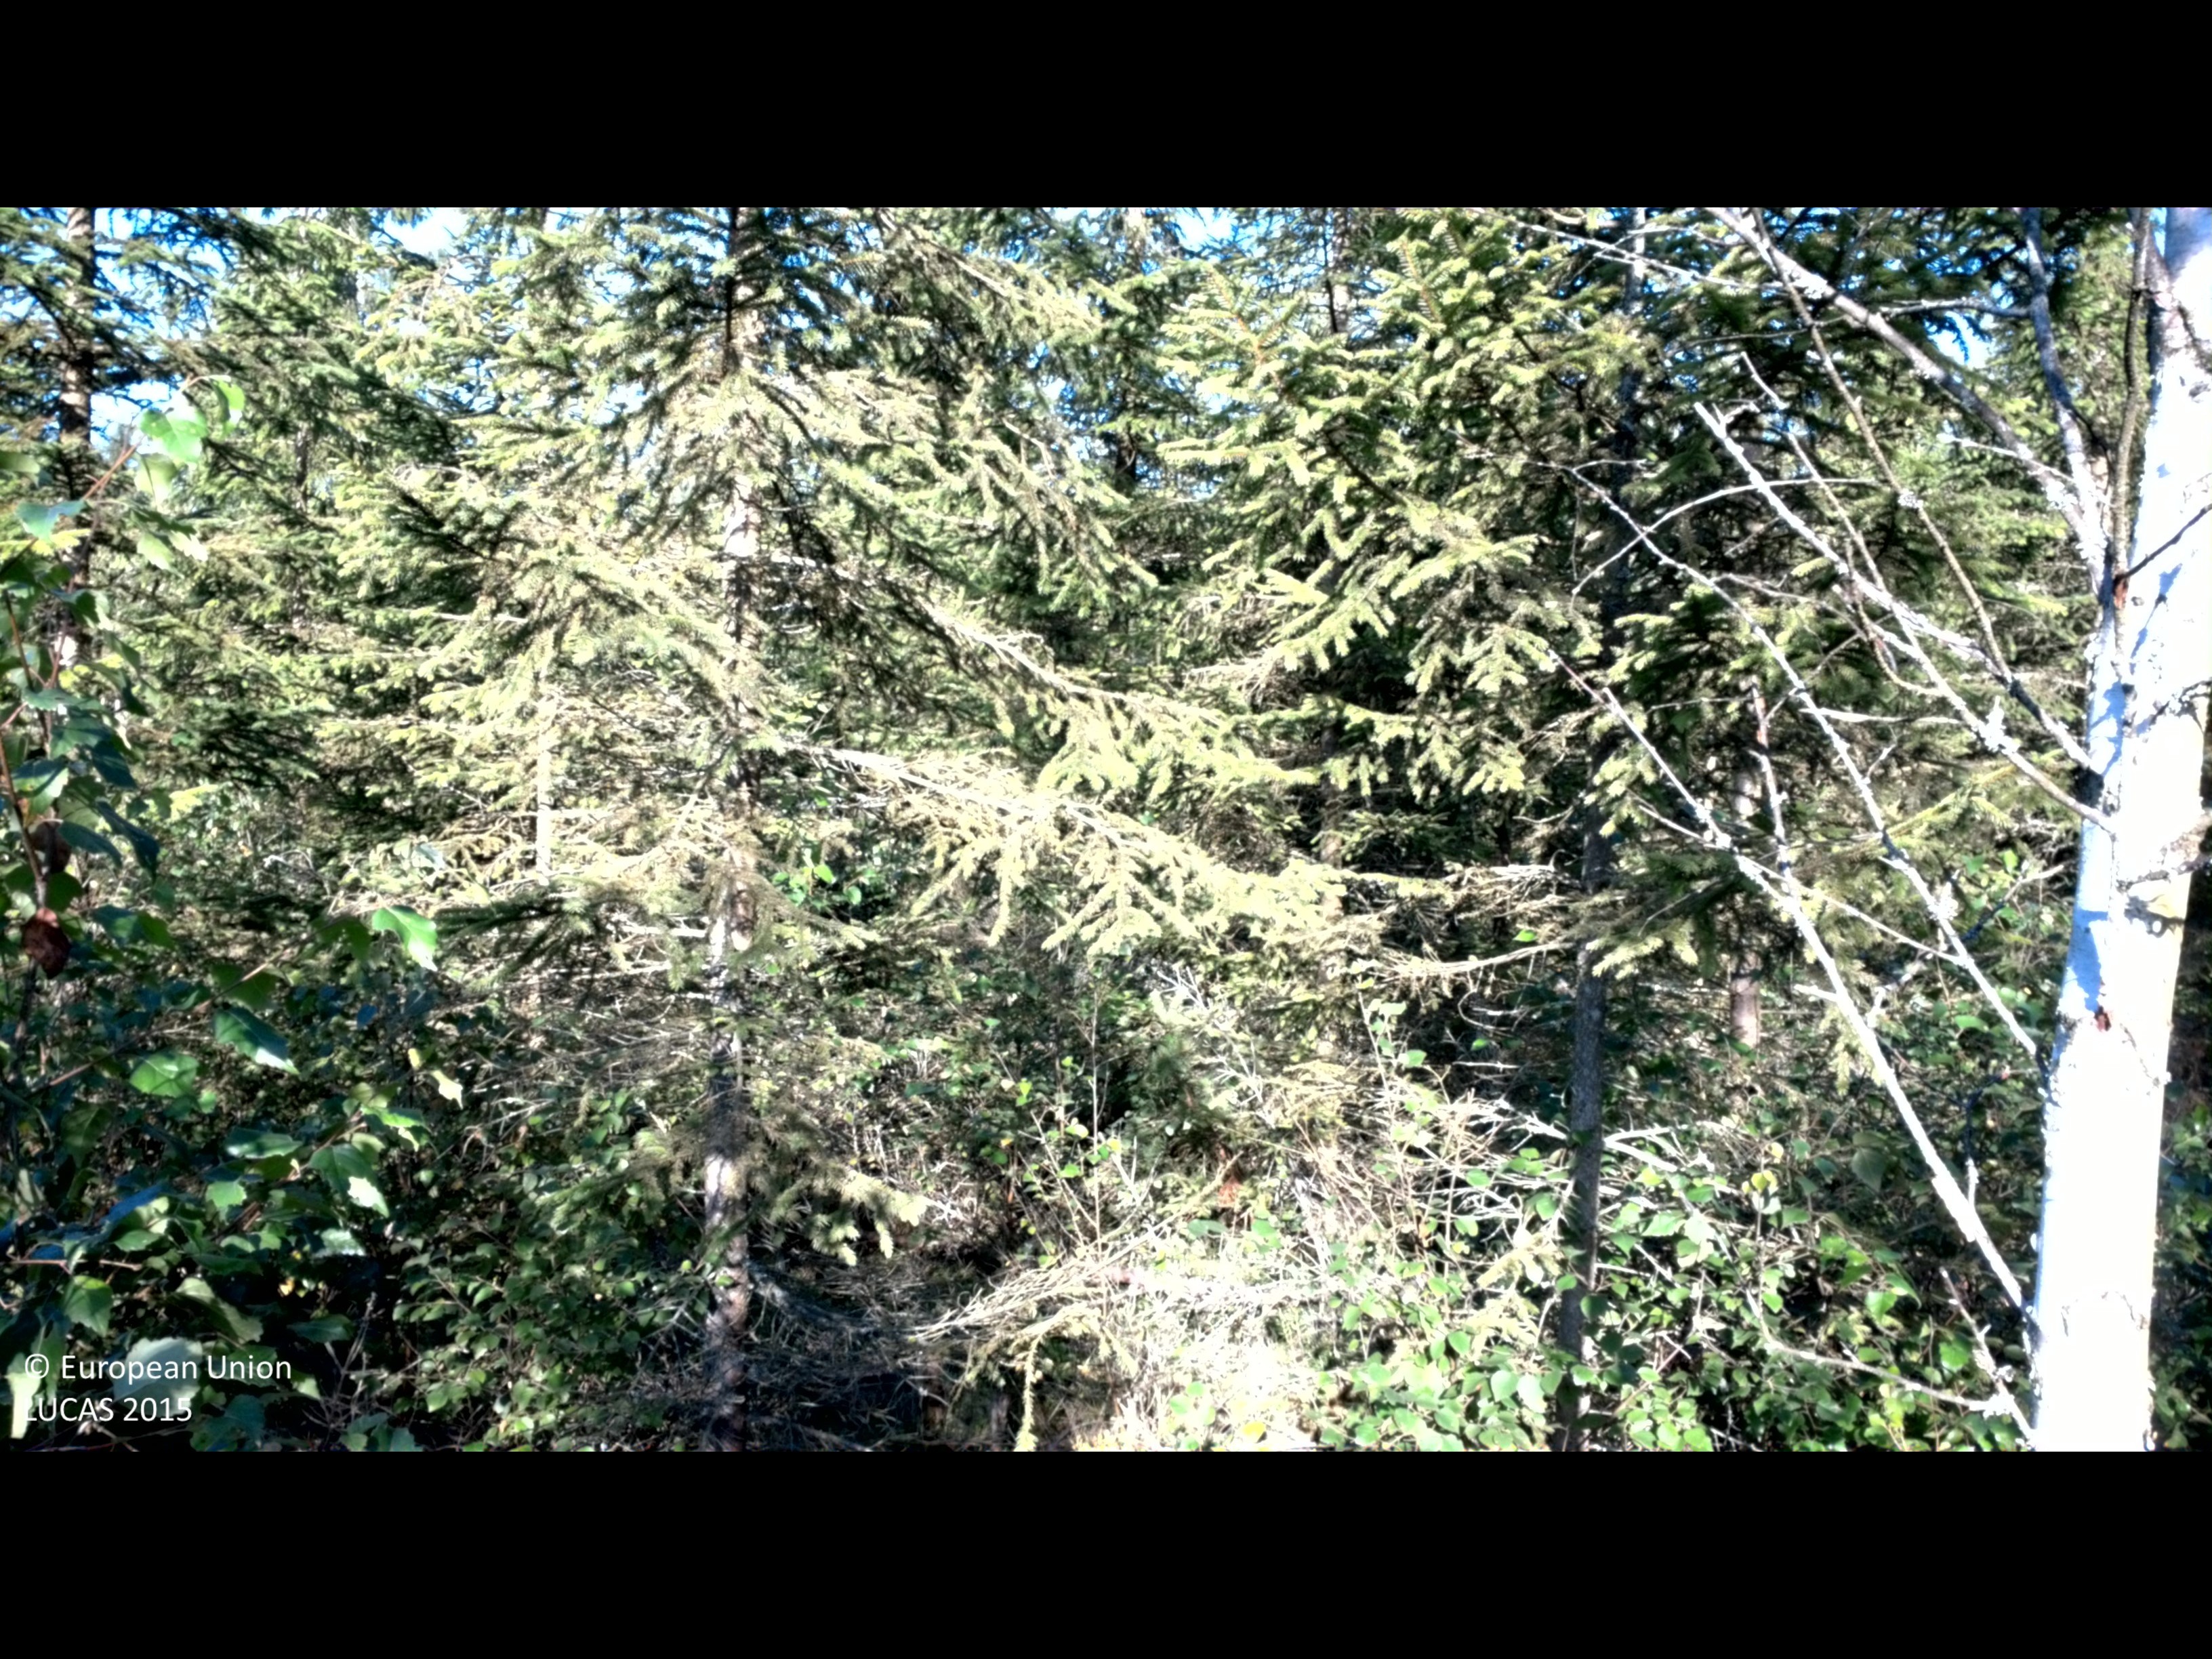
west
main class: Woodland
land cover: Spruce dominated mixed woodland
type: boreal forest
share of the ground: 50 - 75 %
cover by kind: coniferous forest trees 45 %, broadleaved forest trees 30 %, shrubs 25 %
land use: Forestry
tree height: > 5 m
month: August
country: SE
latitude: 56.9567
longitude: 13.2358
